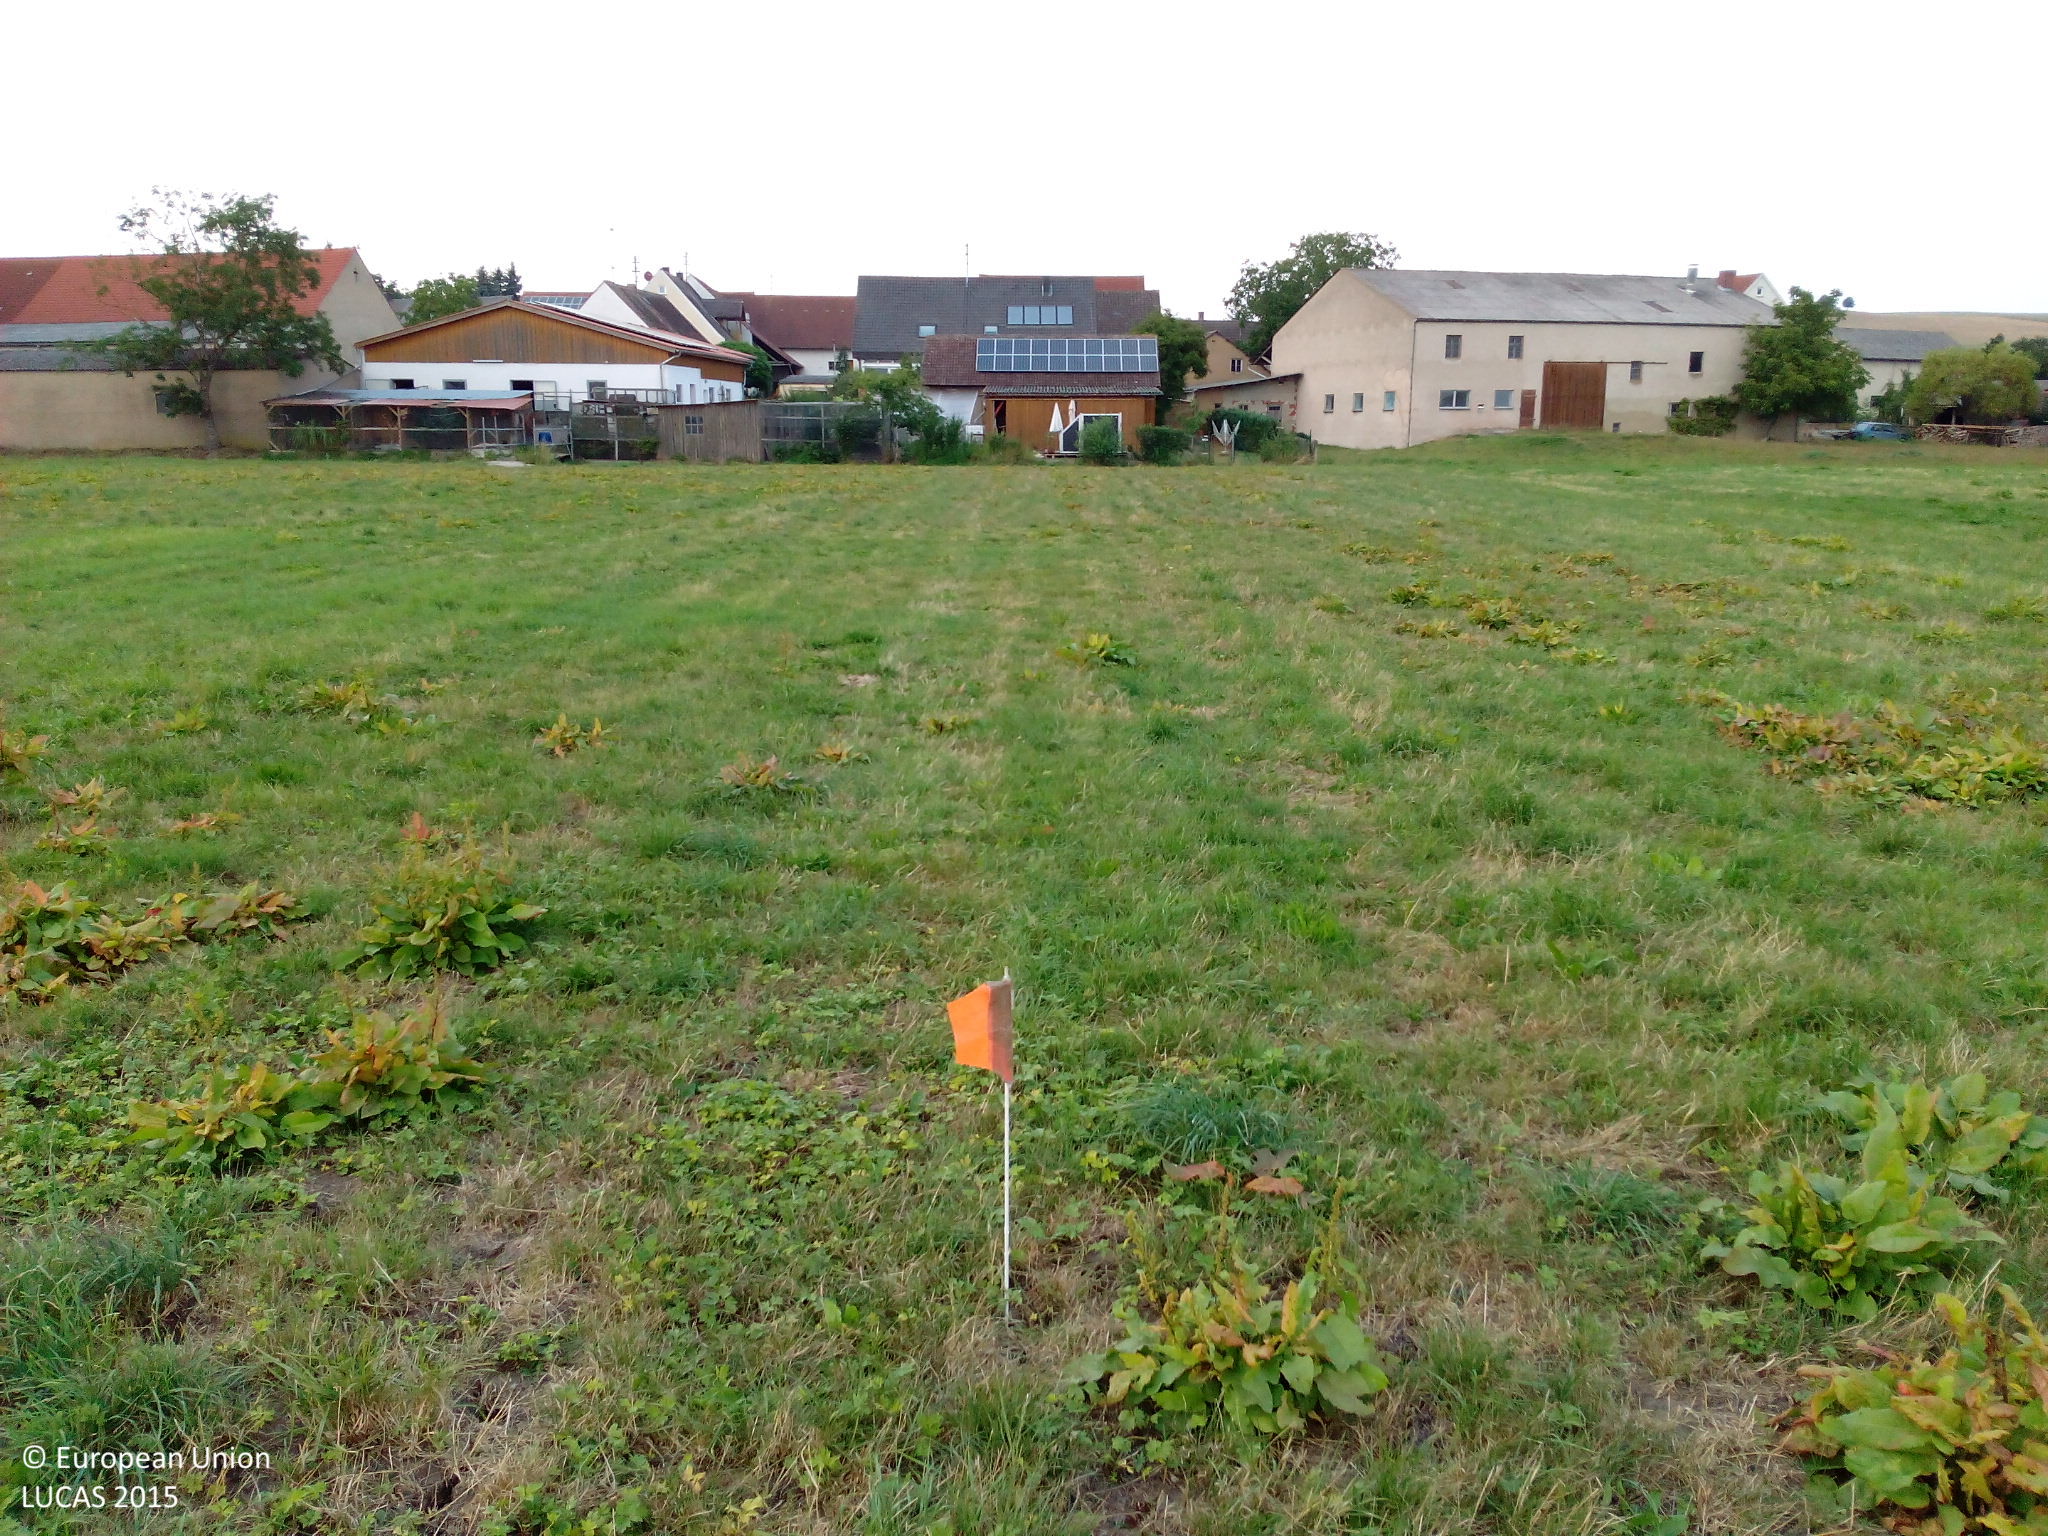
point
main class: Grassland
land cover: Grassland without tree/shrub cover
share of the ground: > 75 %
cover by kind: herbaceous plants 95 %, unconsolidated bare surface 5 %
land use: Agriculture (excluding fallow land and kitchen gardens)
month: August
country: DE
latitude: 48.9599
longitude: 10.5324
